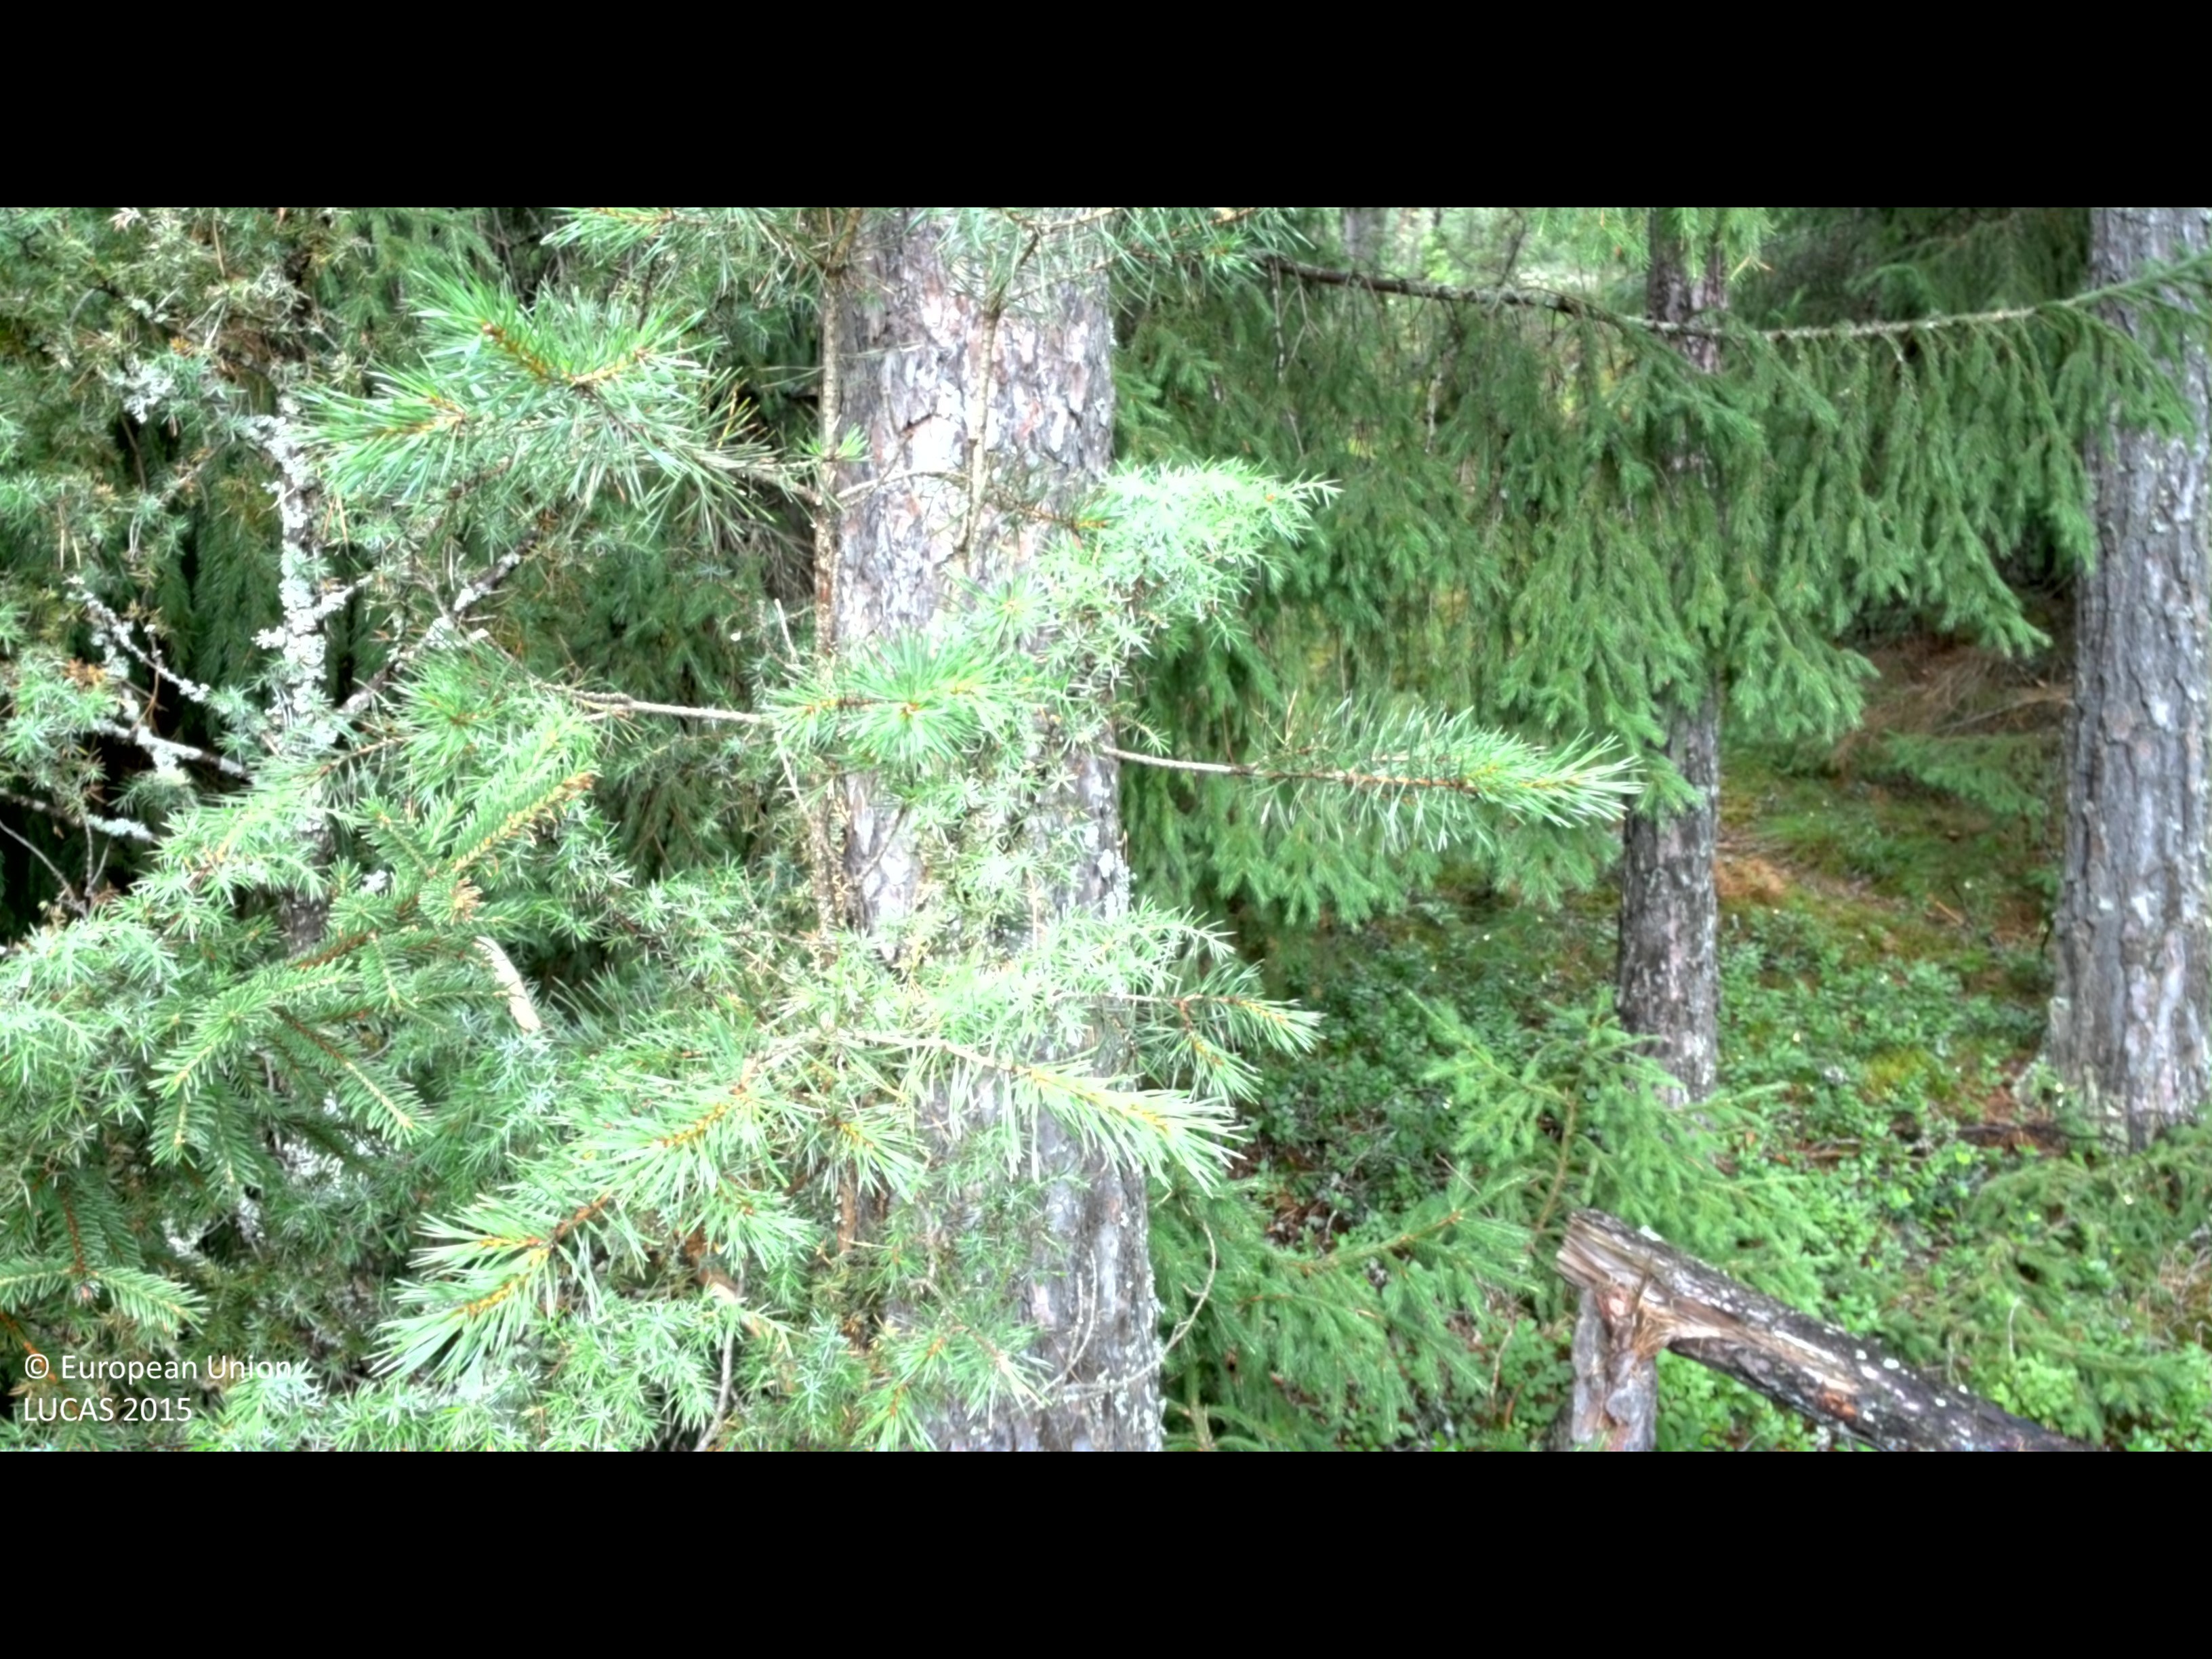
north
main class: Woodland
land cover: Pine dominated coniferous woodland
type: boreal forest
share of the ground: > 75 %
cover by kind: coniferous forest trees 80 %, shrubs 15 %, lichens and mosses 5 %
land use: Forestry
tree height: > 5 m
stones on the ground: 25 - 50 %
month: July
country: SE
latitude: 58.3621
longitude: 16.2688
